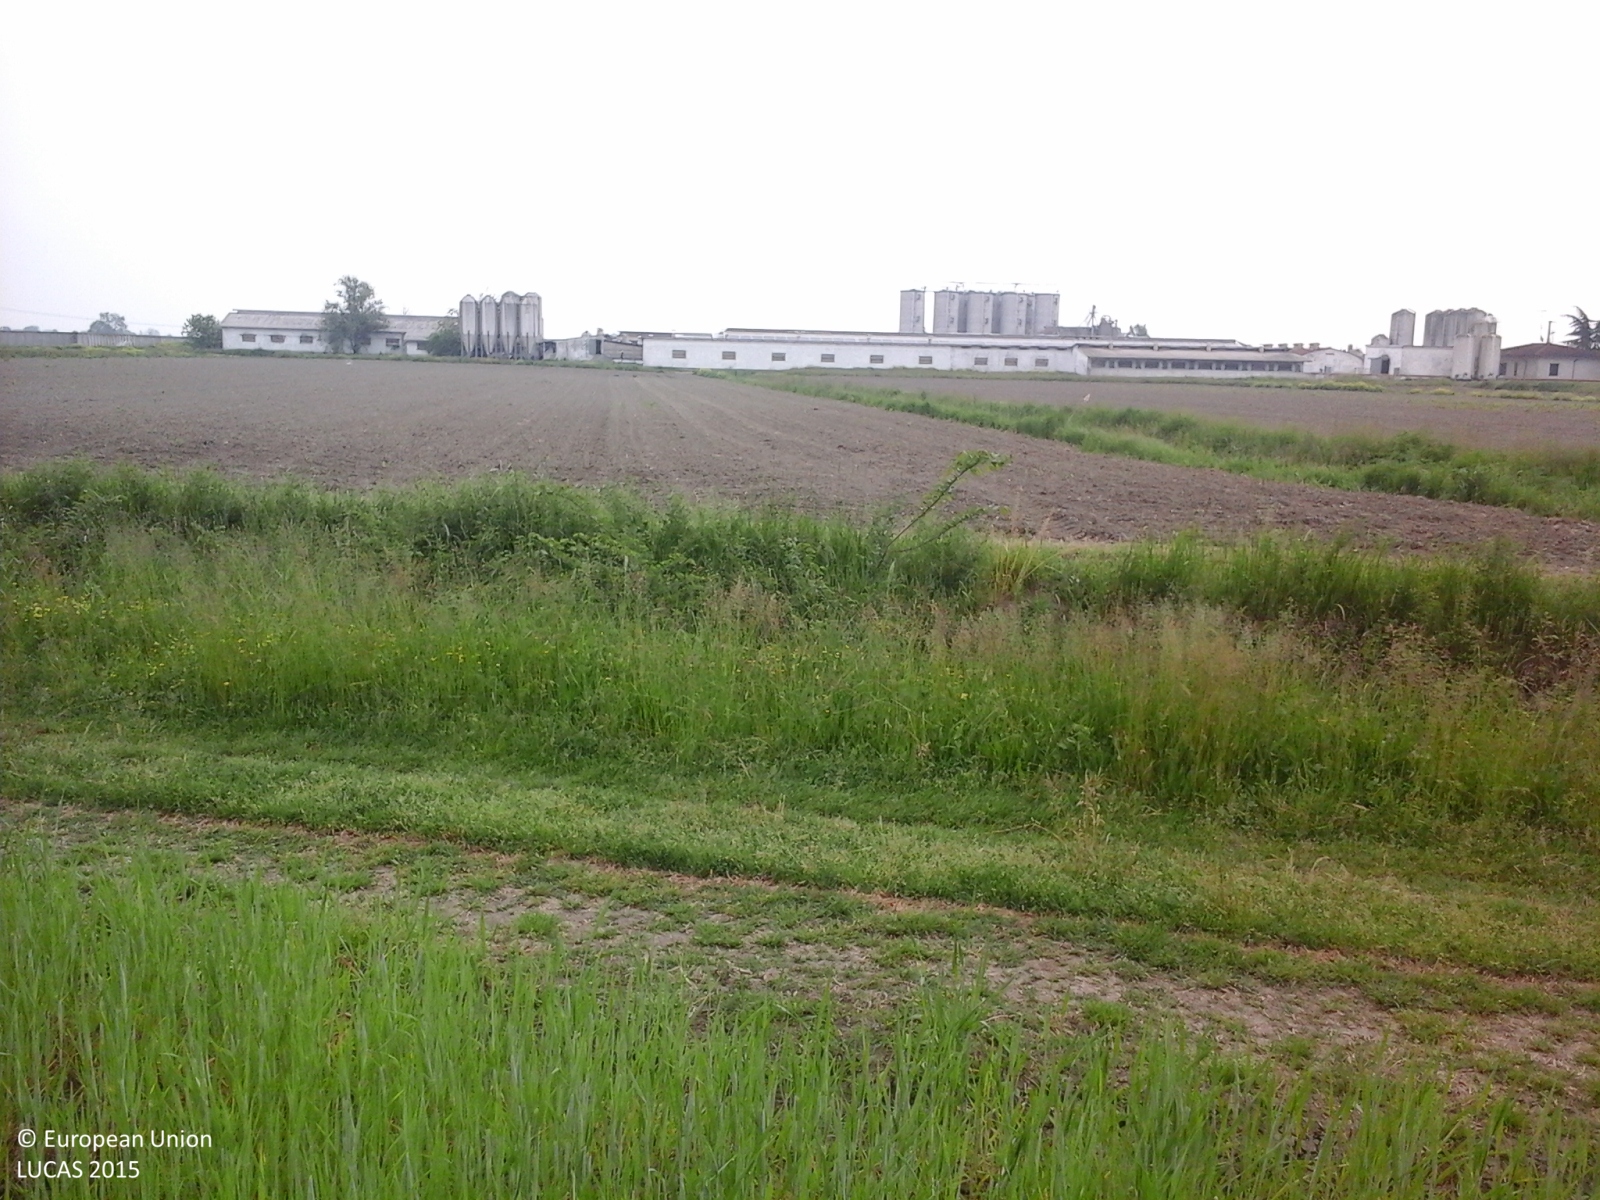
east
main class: Cropland
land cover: Common wheat
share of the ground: > 75 %
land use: Agriculture (excluding fallow land and kitchen gardens)
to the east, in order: Common wheat; Tracks; Grass margins; Ditches and canals; Grass margins; Tracks; Soya; Grass margins; Ditches and canals; Grass margins; Tracks; Soya; Grass margins; Tracks; Spontaneously vegetated surfaces; Artificial constructions in urban areas
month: May
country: IT
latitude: 44.9982
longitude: 10.5697
